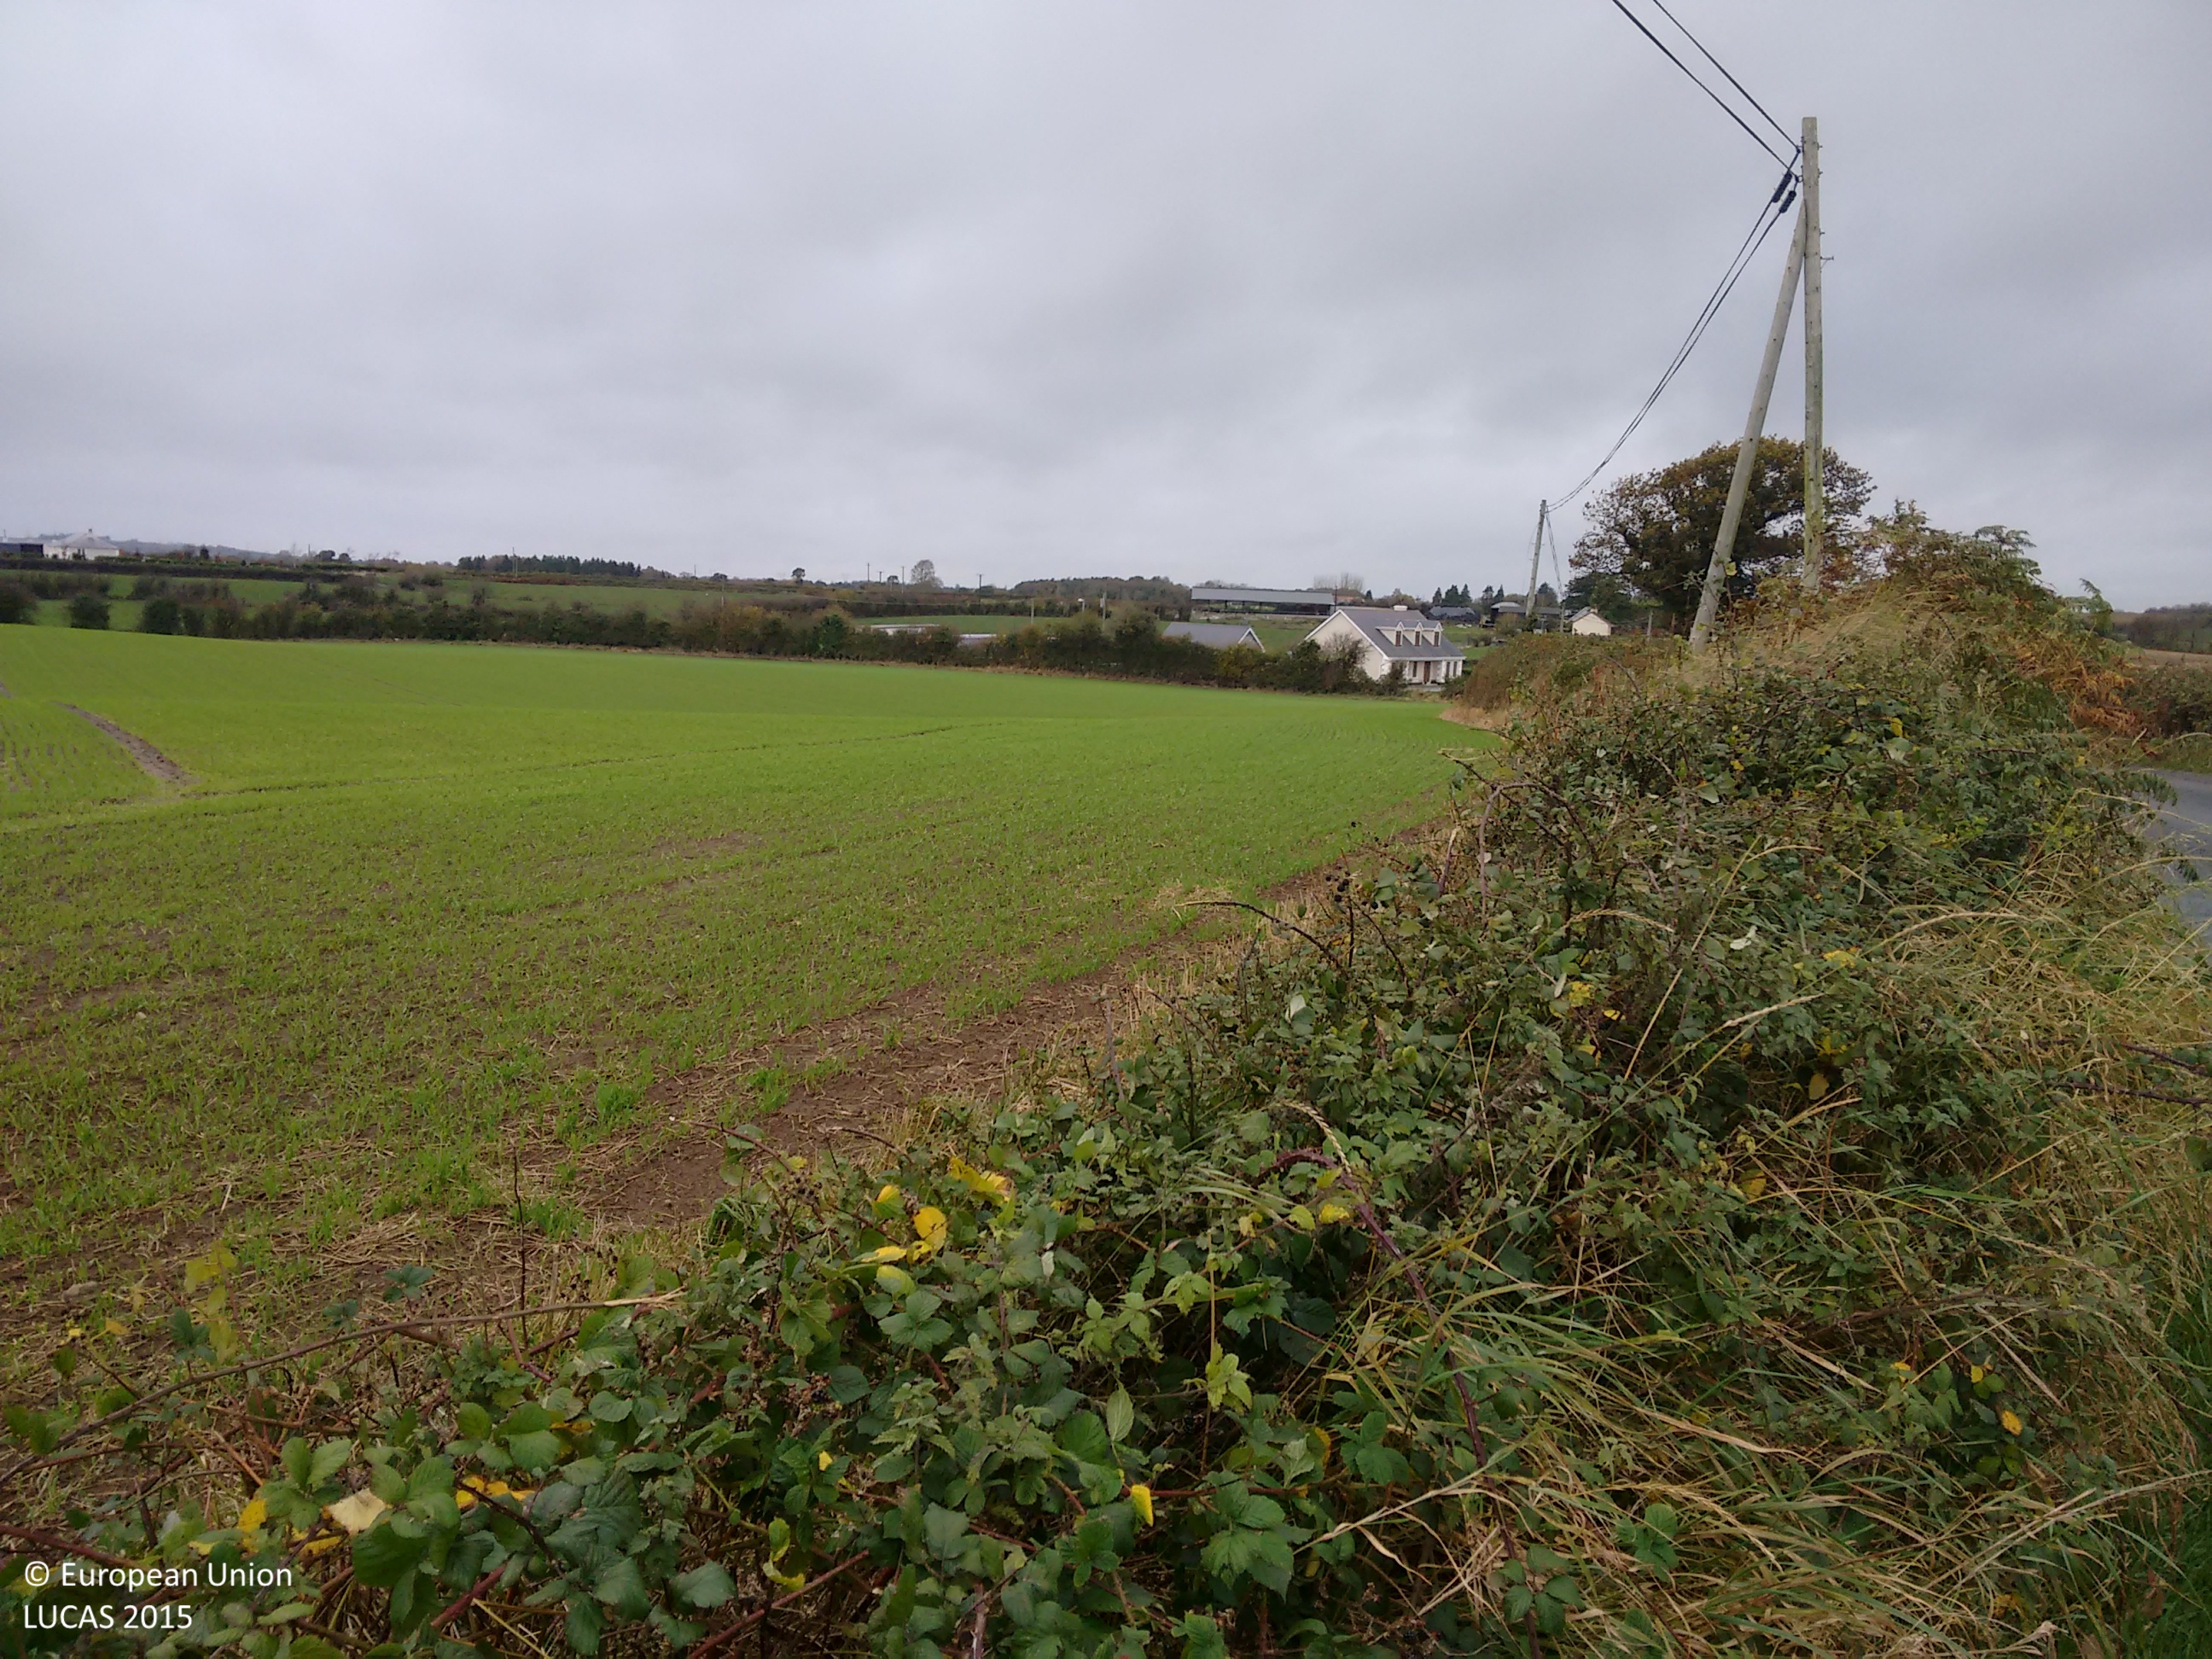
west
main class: Cropland
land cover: Common wheat
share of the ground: > 75 %
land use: Agriculture (excluding fallow land and kitchen gardens)
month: November
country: IE
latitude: 53.1857
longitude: -7.5958
